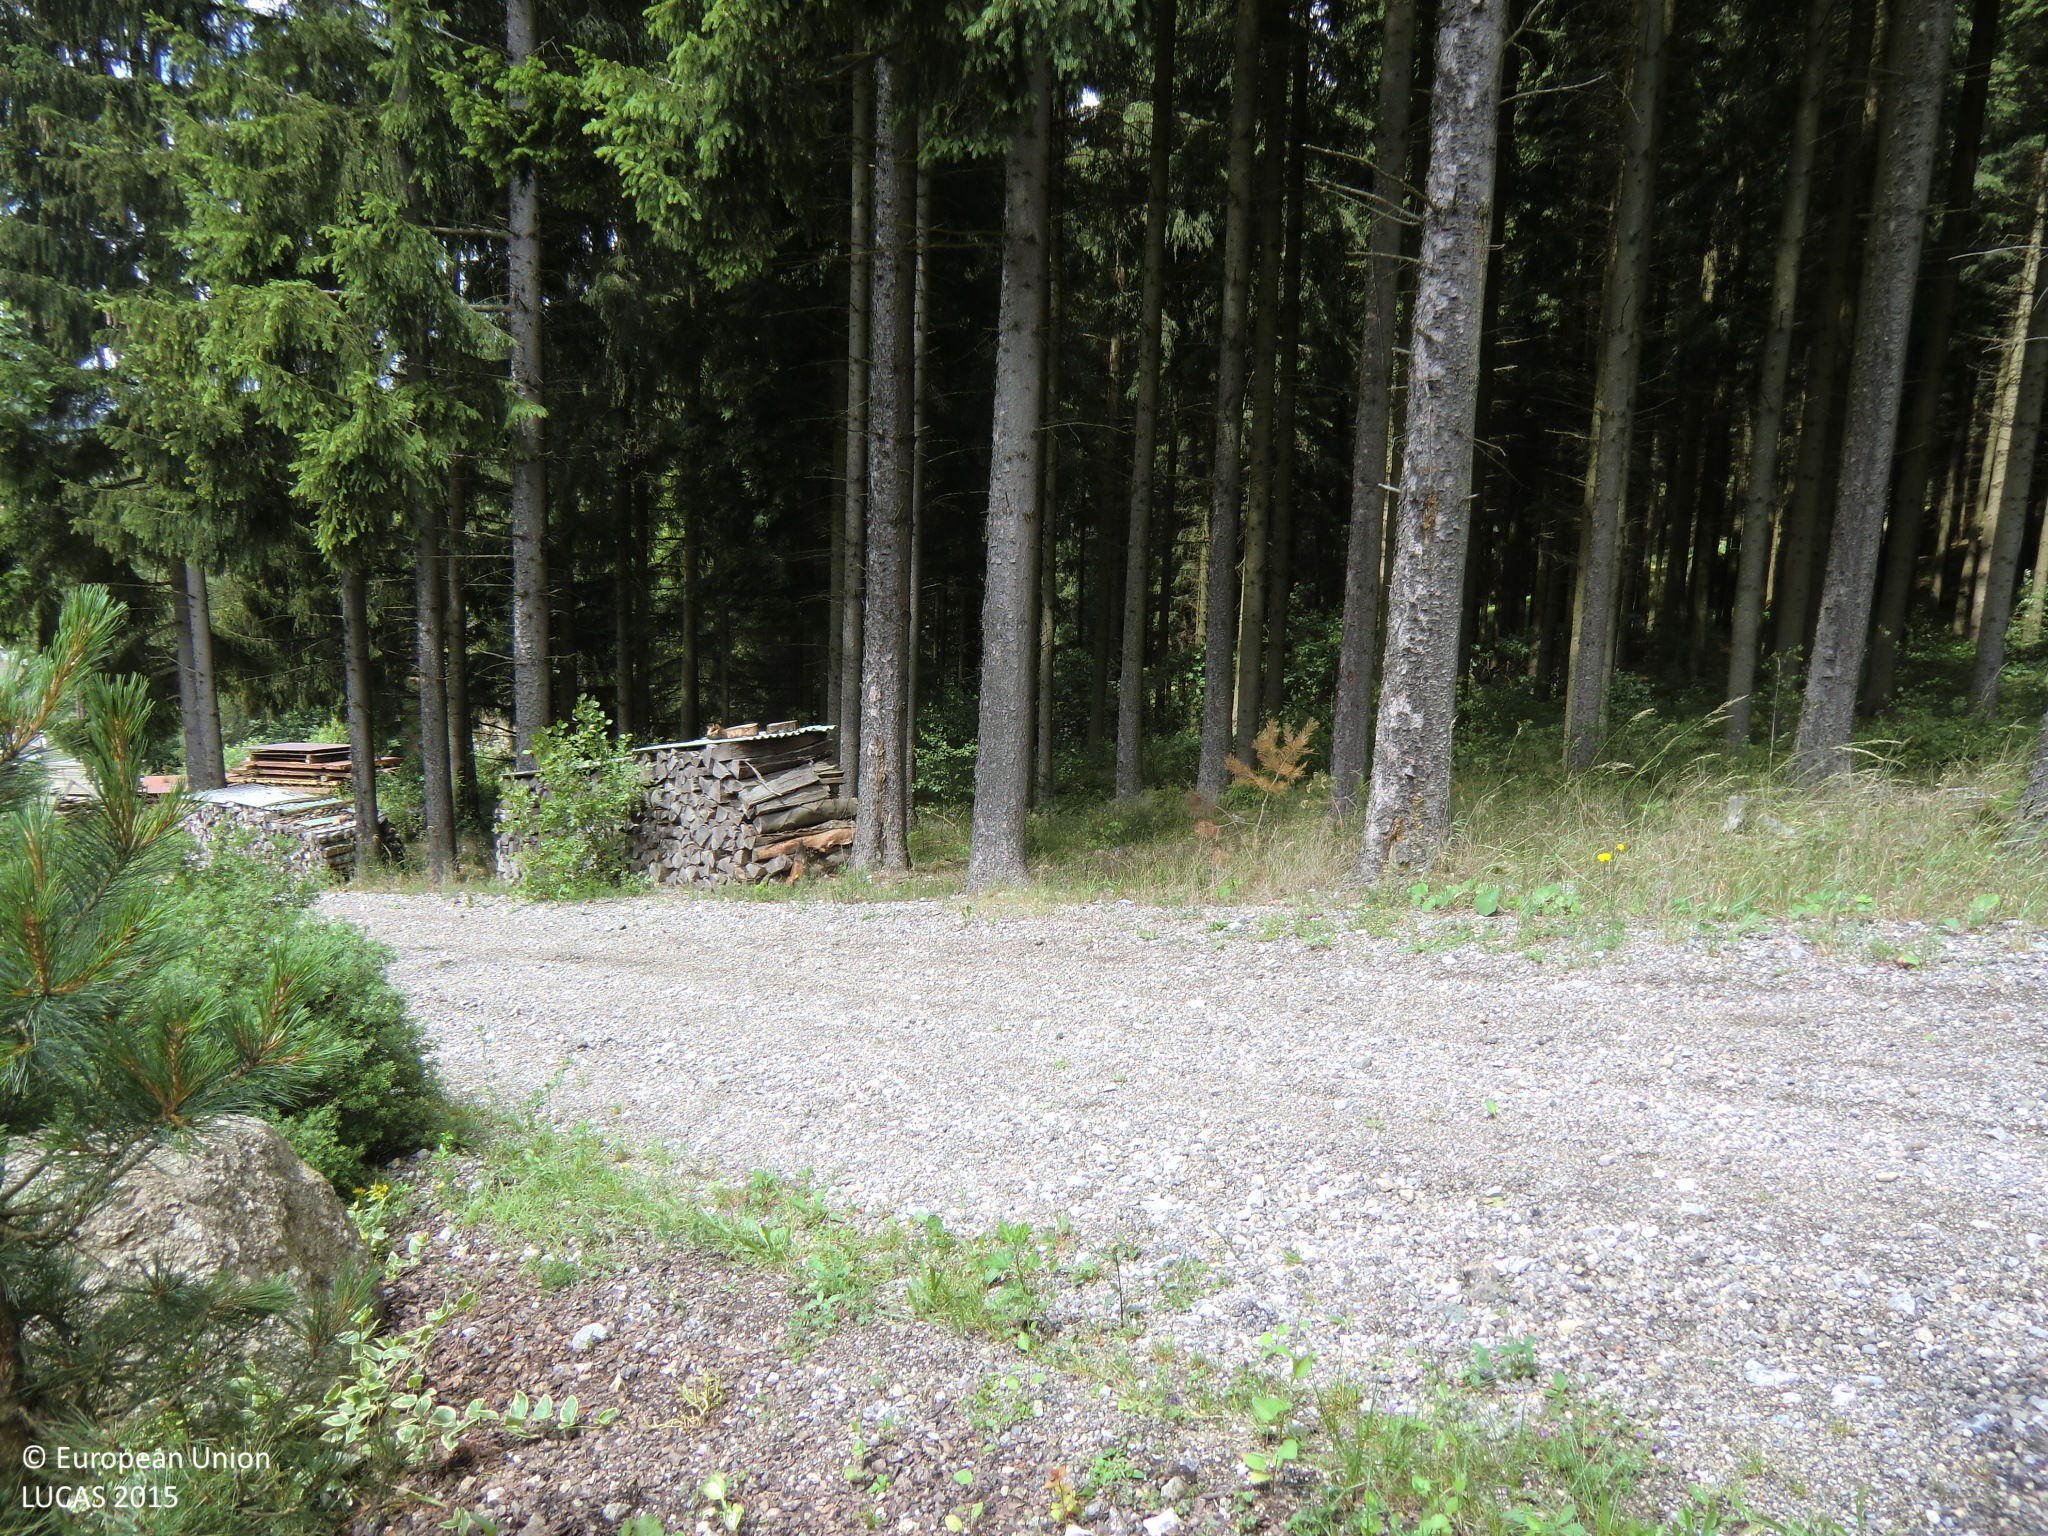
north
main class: Woodland
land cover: Broadleaved woodland
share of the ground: 50 - 75 %
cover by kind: broadleaved forest trees 65 %, herbaceous plants 25 %, unconsolidated bare surface 10 %
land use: Semi-natural and natural areas not in use
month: June
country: AT
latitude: 48.4506
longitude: 15.0448
